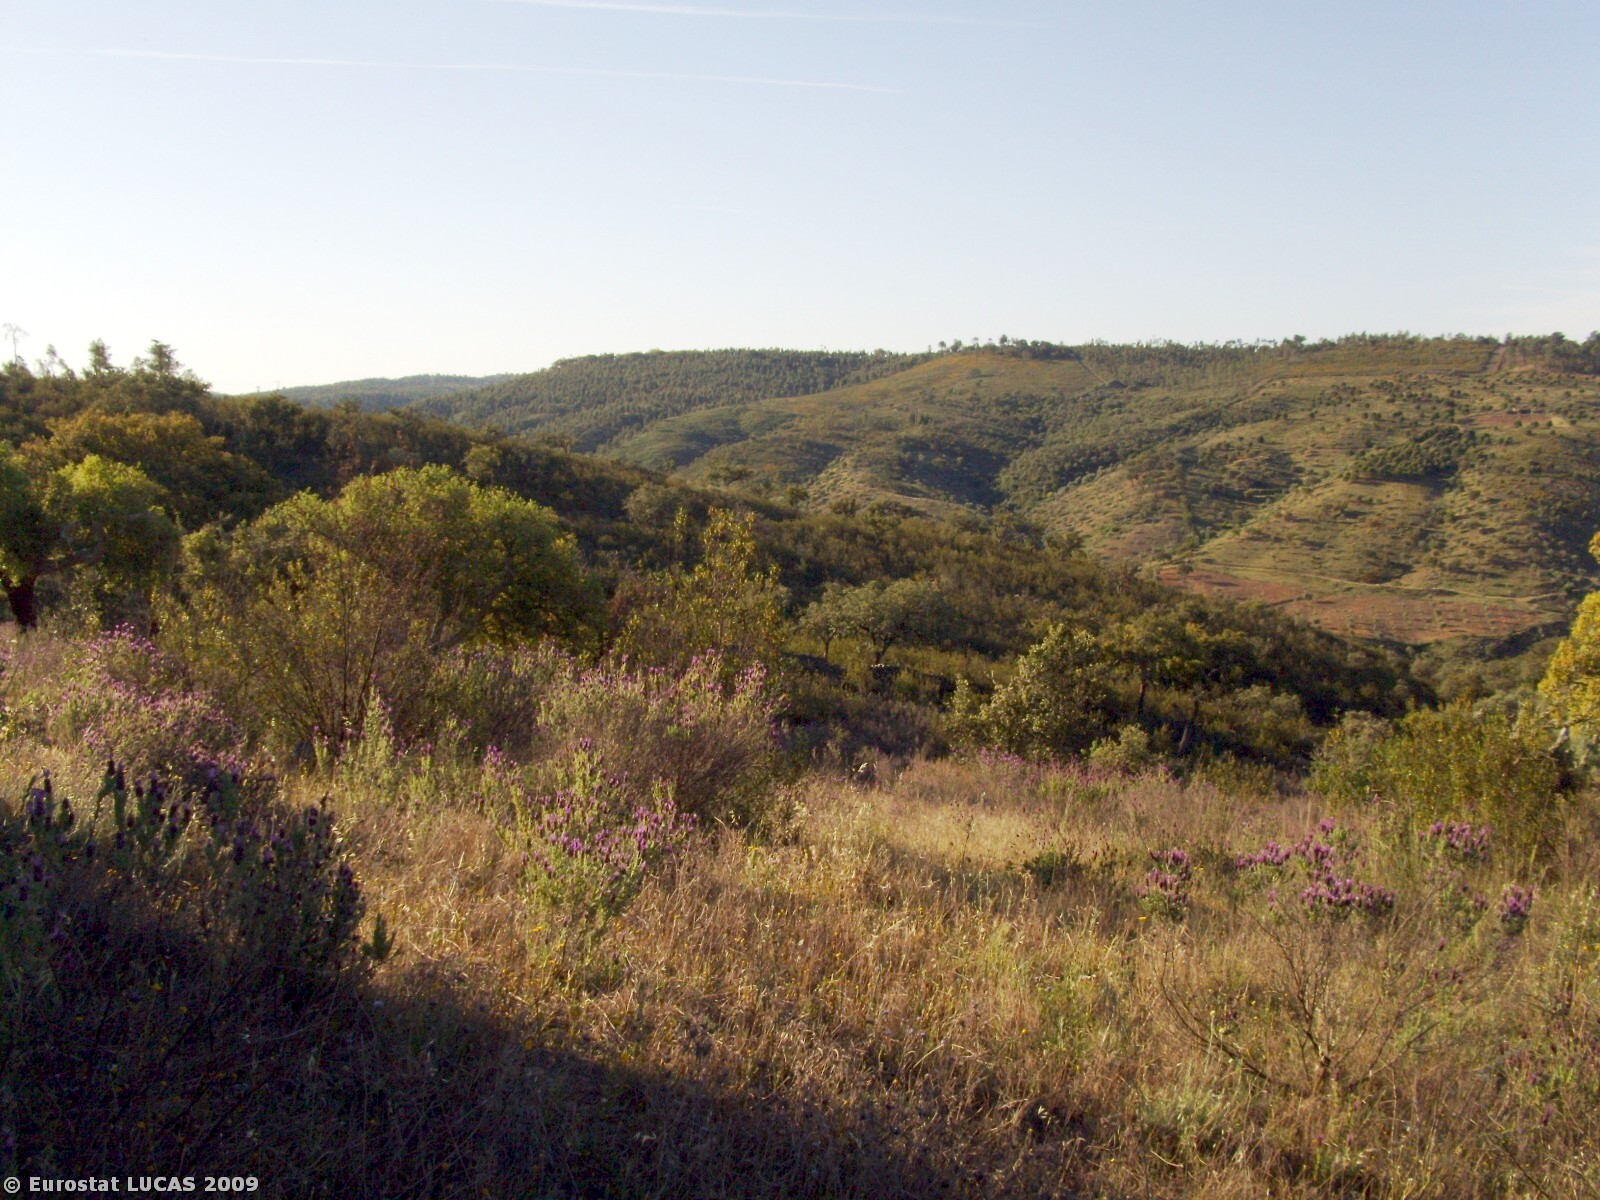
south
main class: Woodland
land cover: Broadleaved woodland
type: broadleaved evergreen forest
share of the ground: 25 - 50 %
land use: Forestry
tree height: > 5 m
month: May
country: PT
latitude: 39.6645
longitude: -7.5711
